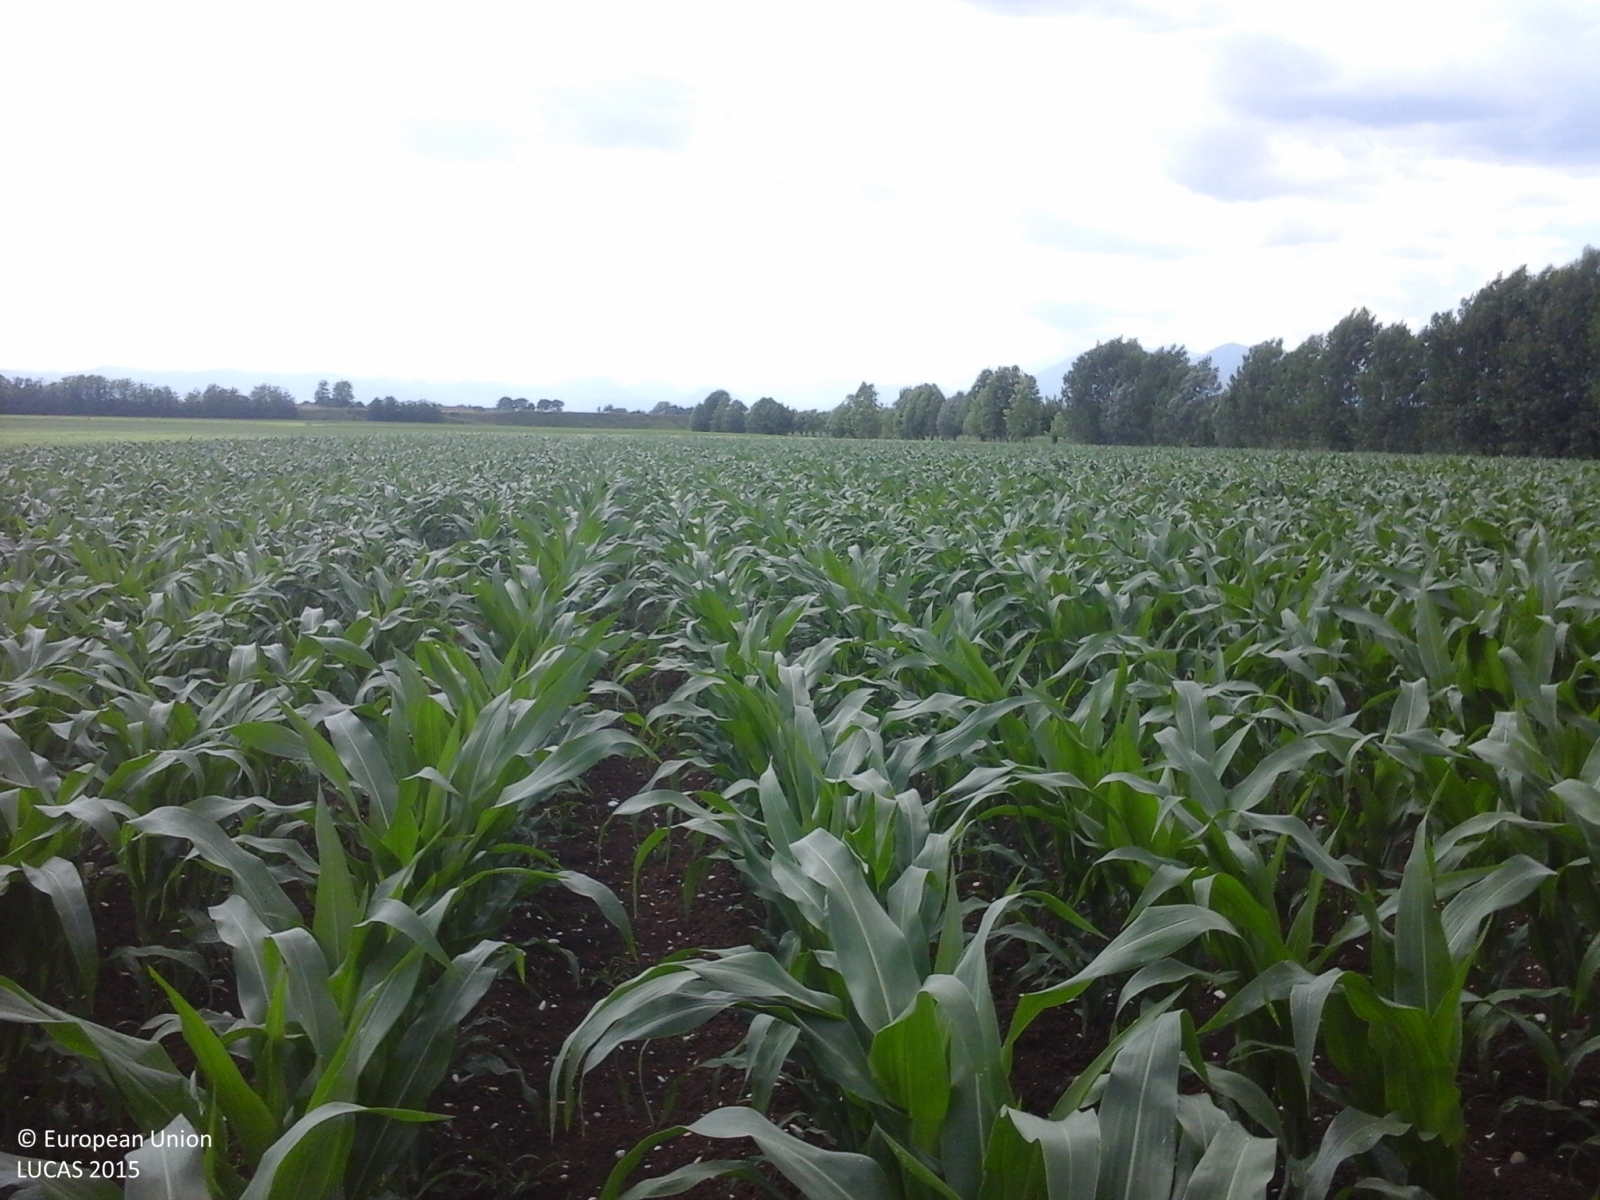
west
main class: Cropland
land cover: Maize
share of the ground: > 75 %
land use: Agriculture (excluding fallow land and kitchen gardens)
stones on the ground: 10 - 25 %
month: May
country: IT
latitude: 45.6901
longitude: 11.6283
